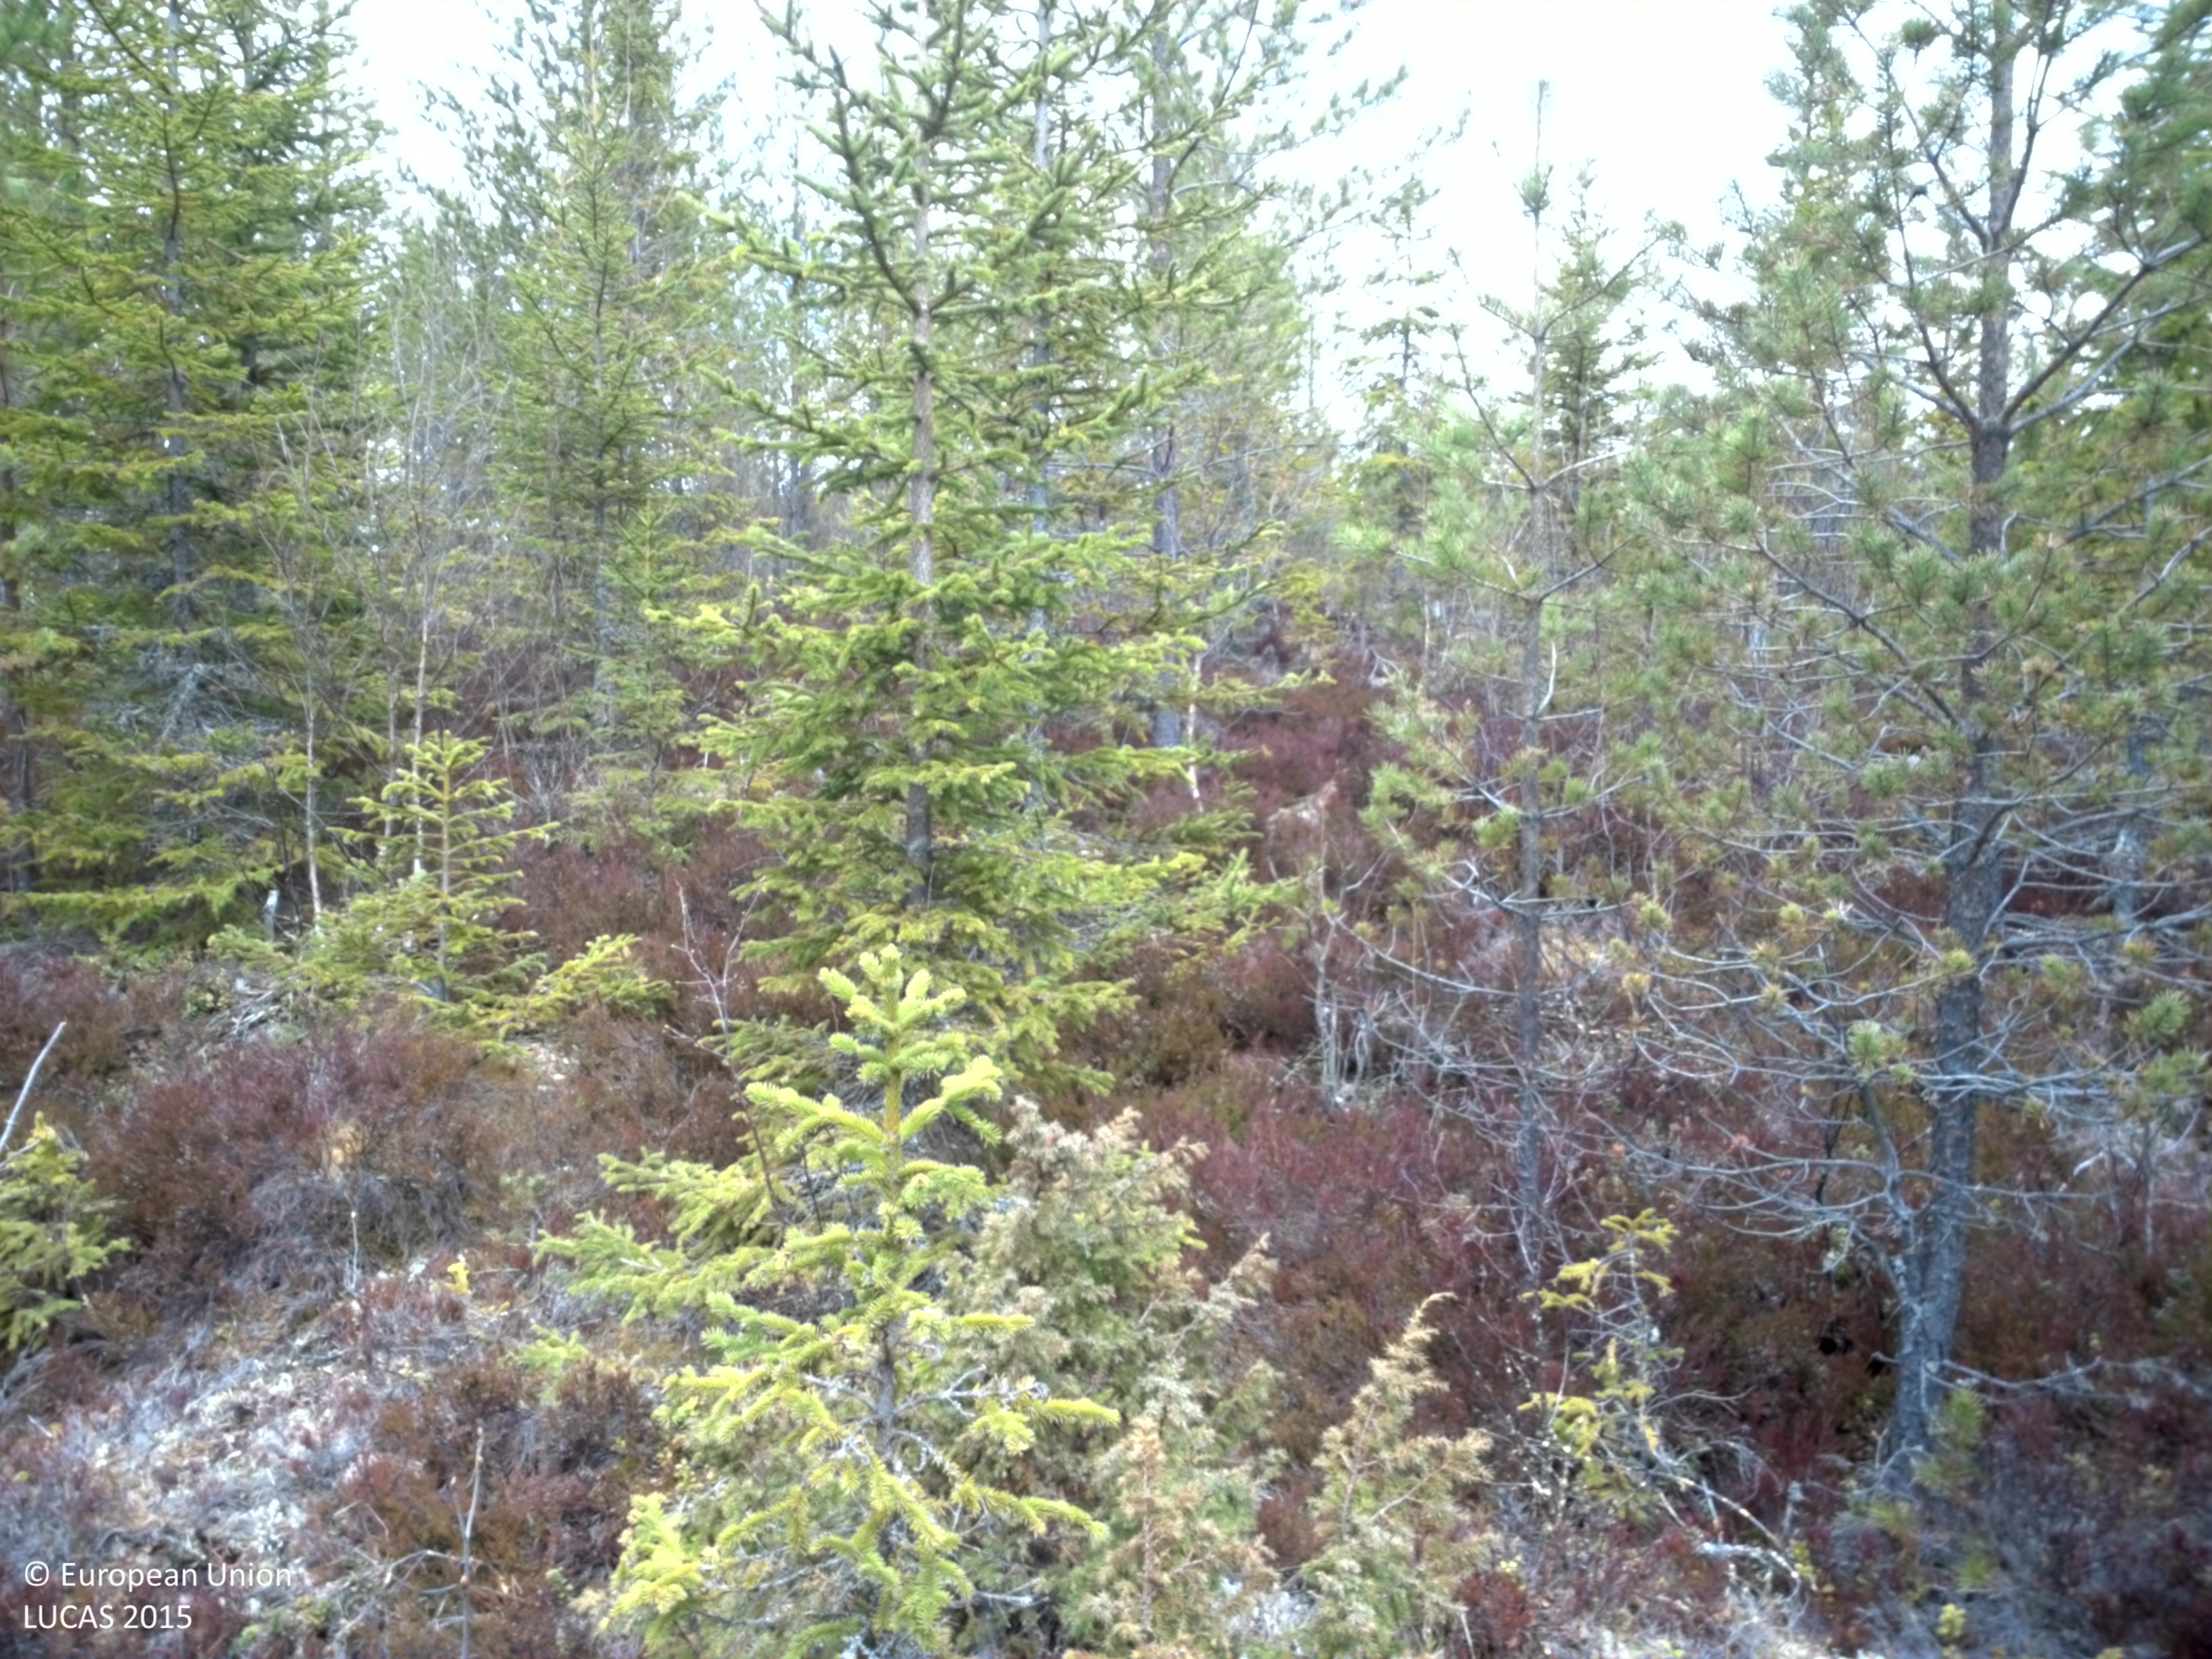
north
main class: Woodland
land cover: Spruce dominated coniferous woodland
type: boreal forest
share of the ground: > 75 %
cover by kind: coniferous forest trees 80 %, shrubs 20 %
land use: Forestry
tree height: > 5 m
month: May
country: SE
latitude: 62.6190
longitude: 14.4446
